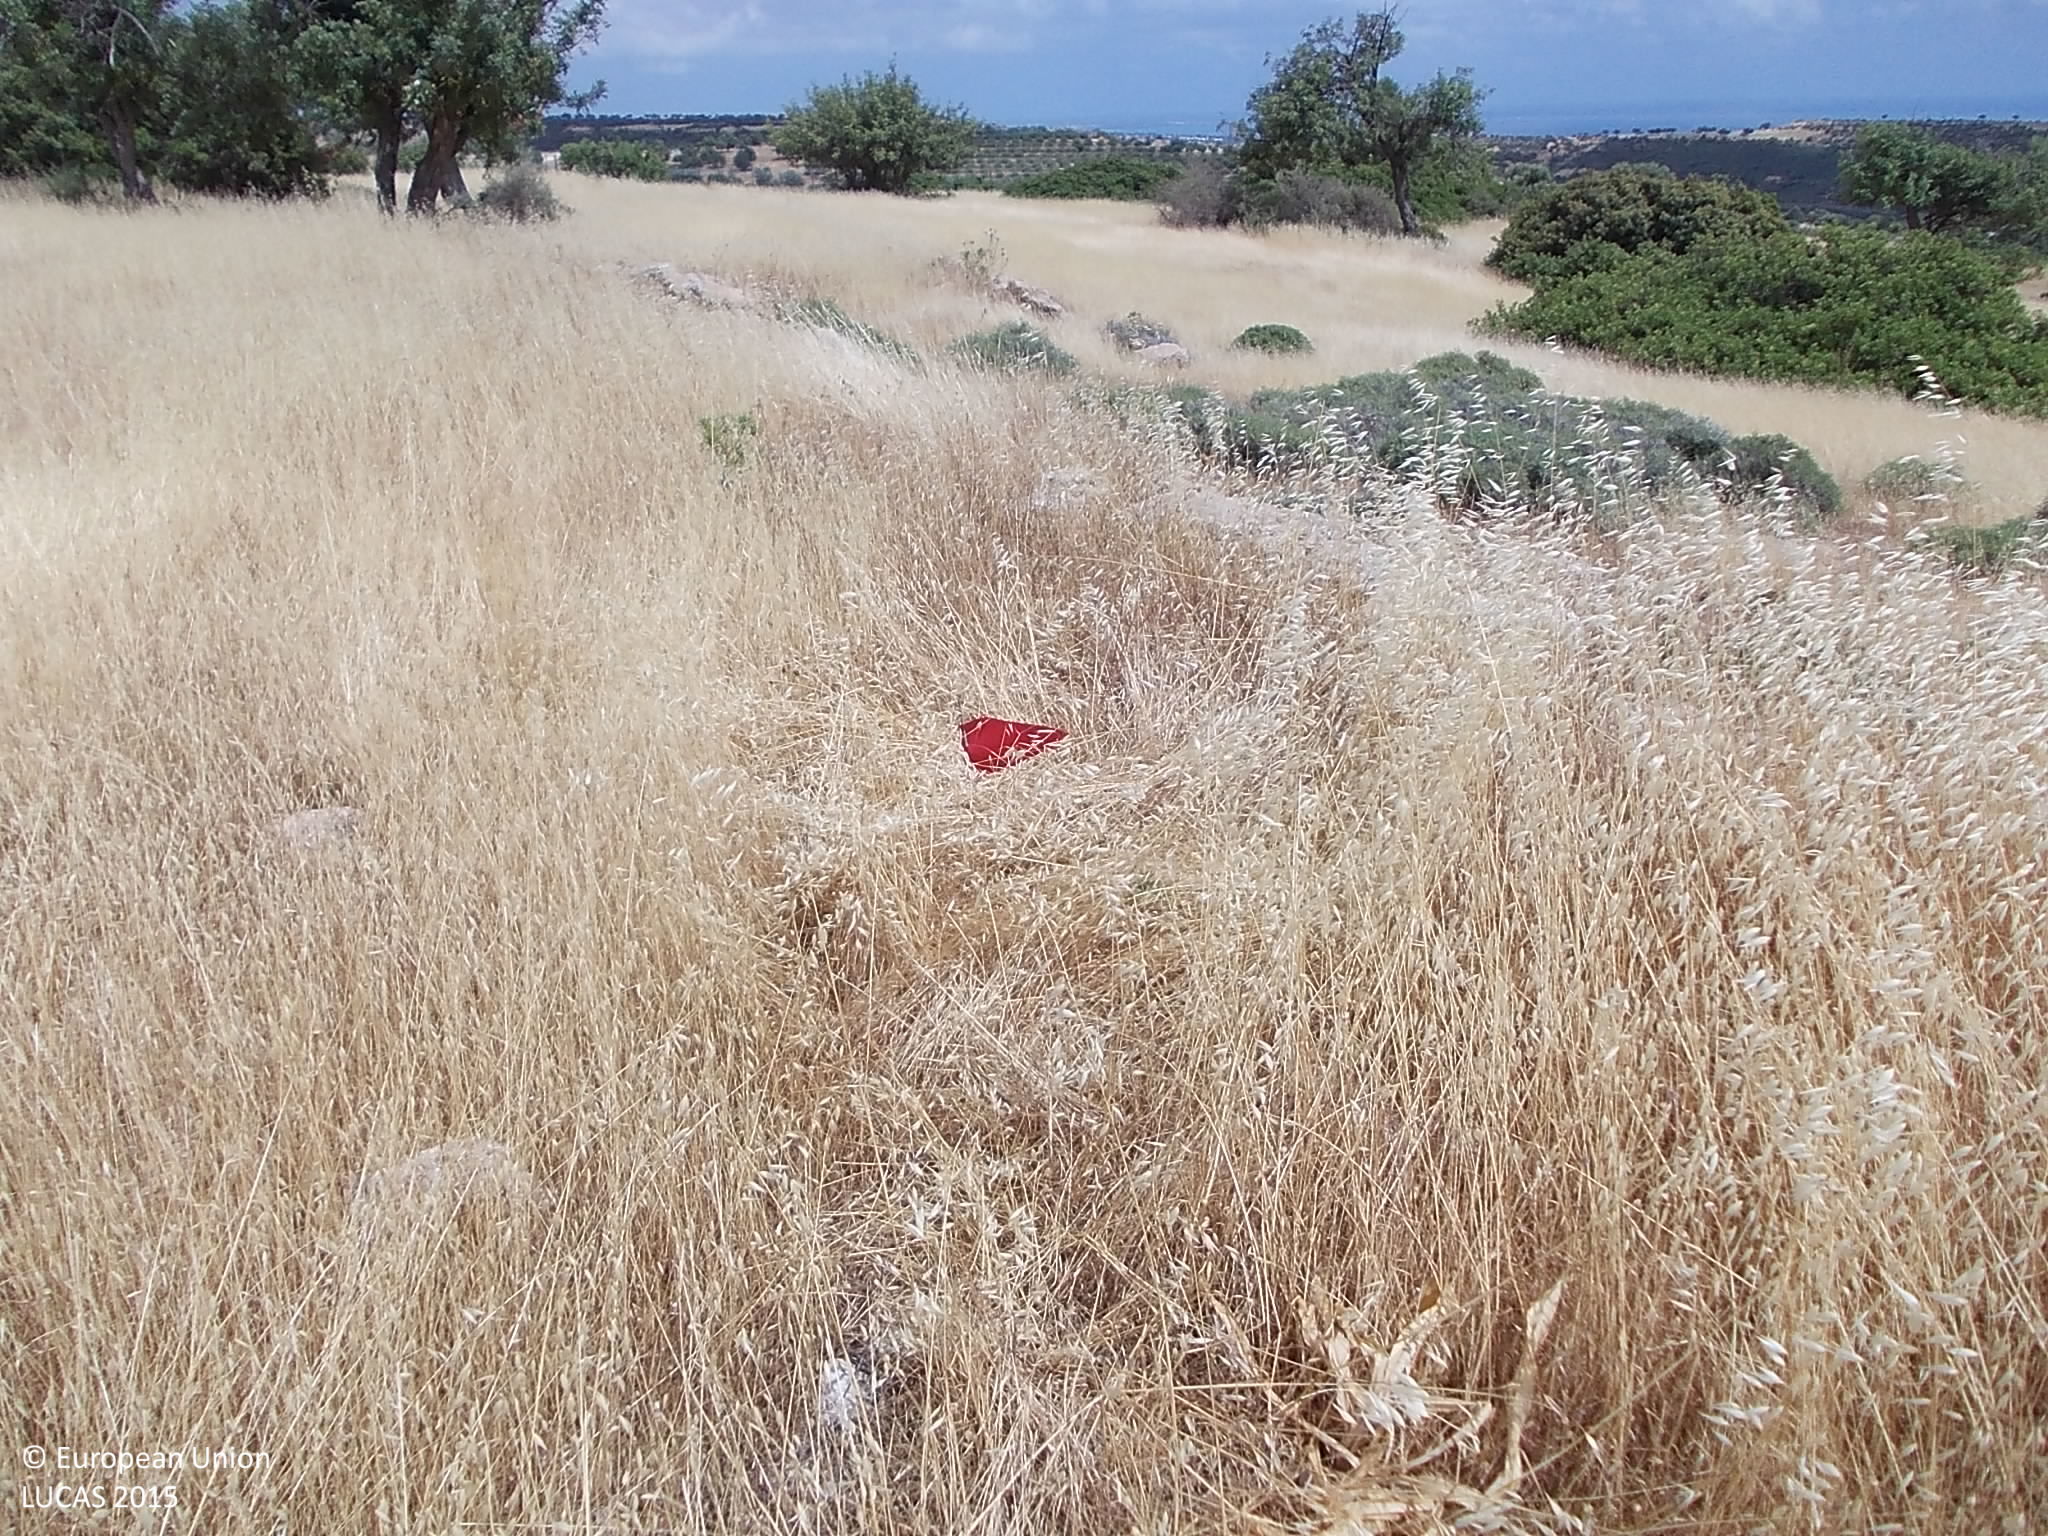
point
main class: Grassland
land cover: Grassland with sparse tree/shrub cover
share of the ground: > 75 %
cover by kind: herbaceous plants 85 %, coniferous forest trees 5 %, shrubs 5 %, consolidated bare surface 5 %
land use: Semi-natural and natural areas not in use
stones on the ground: 10 - 25 %
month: May
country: CY
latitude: 34.7211
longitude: 32.7707
